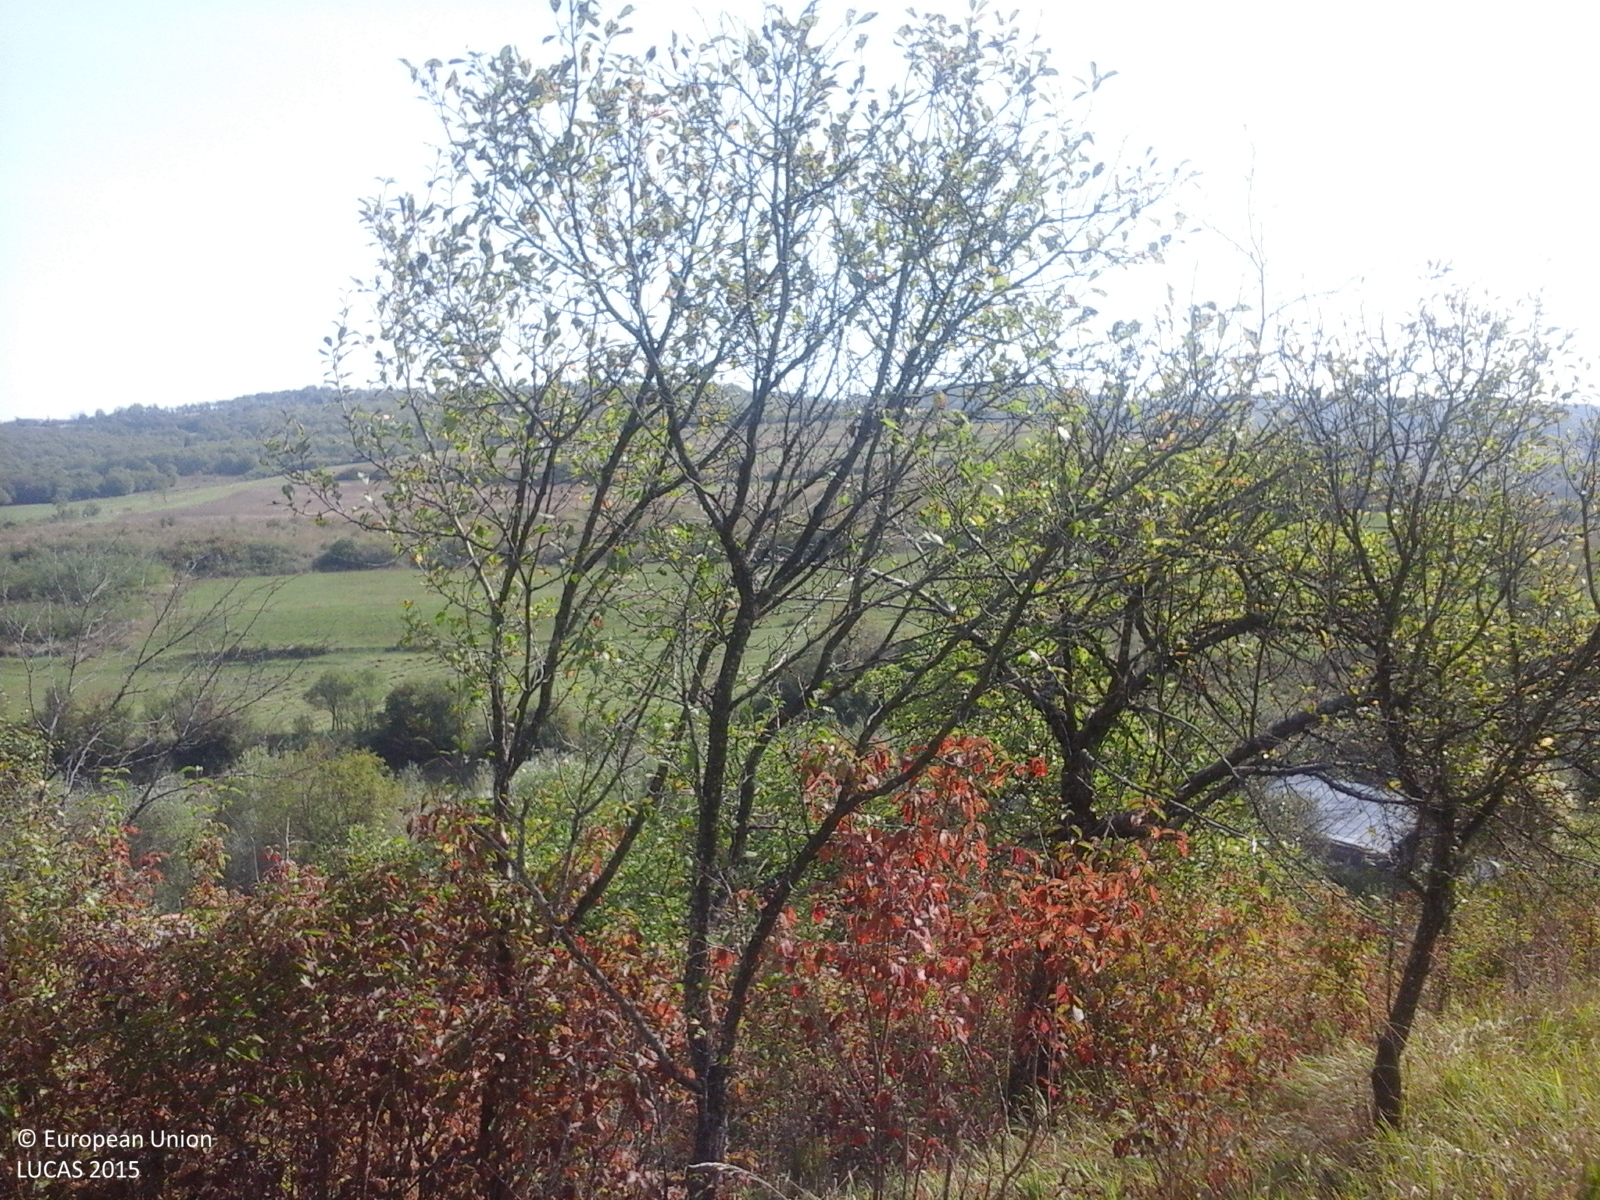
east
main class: Grassland
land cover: Grassland without tree/shrub cover
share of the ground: > 75 %
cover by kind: herbaceous plants 100 %
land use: Agriculture (excluding fallow land and kitchen gardens)
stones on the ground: < 10 %
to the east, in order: Grassland without tree/shrub cover; Shrubland with sparse tree cover; Spontaneously vegetated surfaces; Artificial constructions in urban areas; Lines of trees; Grass margins; Tracks; Electric lines; Grass margins; Shrubland with sparse tree cover; Ditches and canals; Shrubland with sparse tree cover; Grassland without tree/shrub cover; Abandoned hedges; Grassland without tree/shrub cover
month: September
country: RO
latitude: 47.1077
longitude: 23.9828
